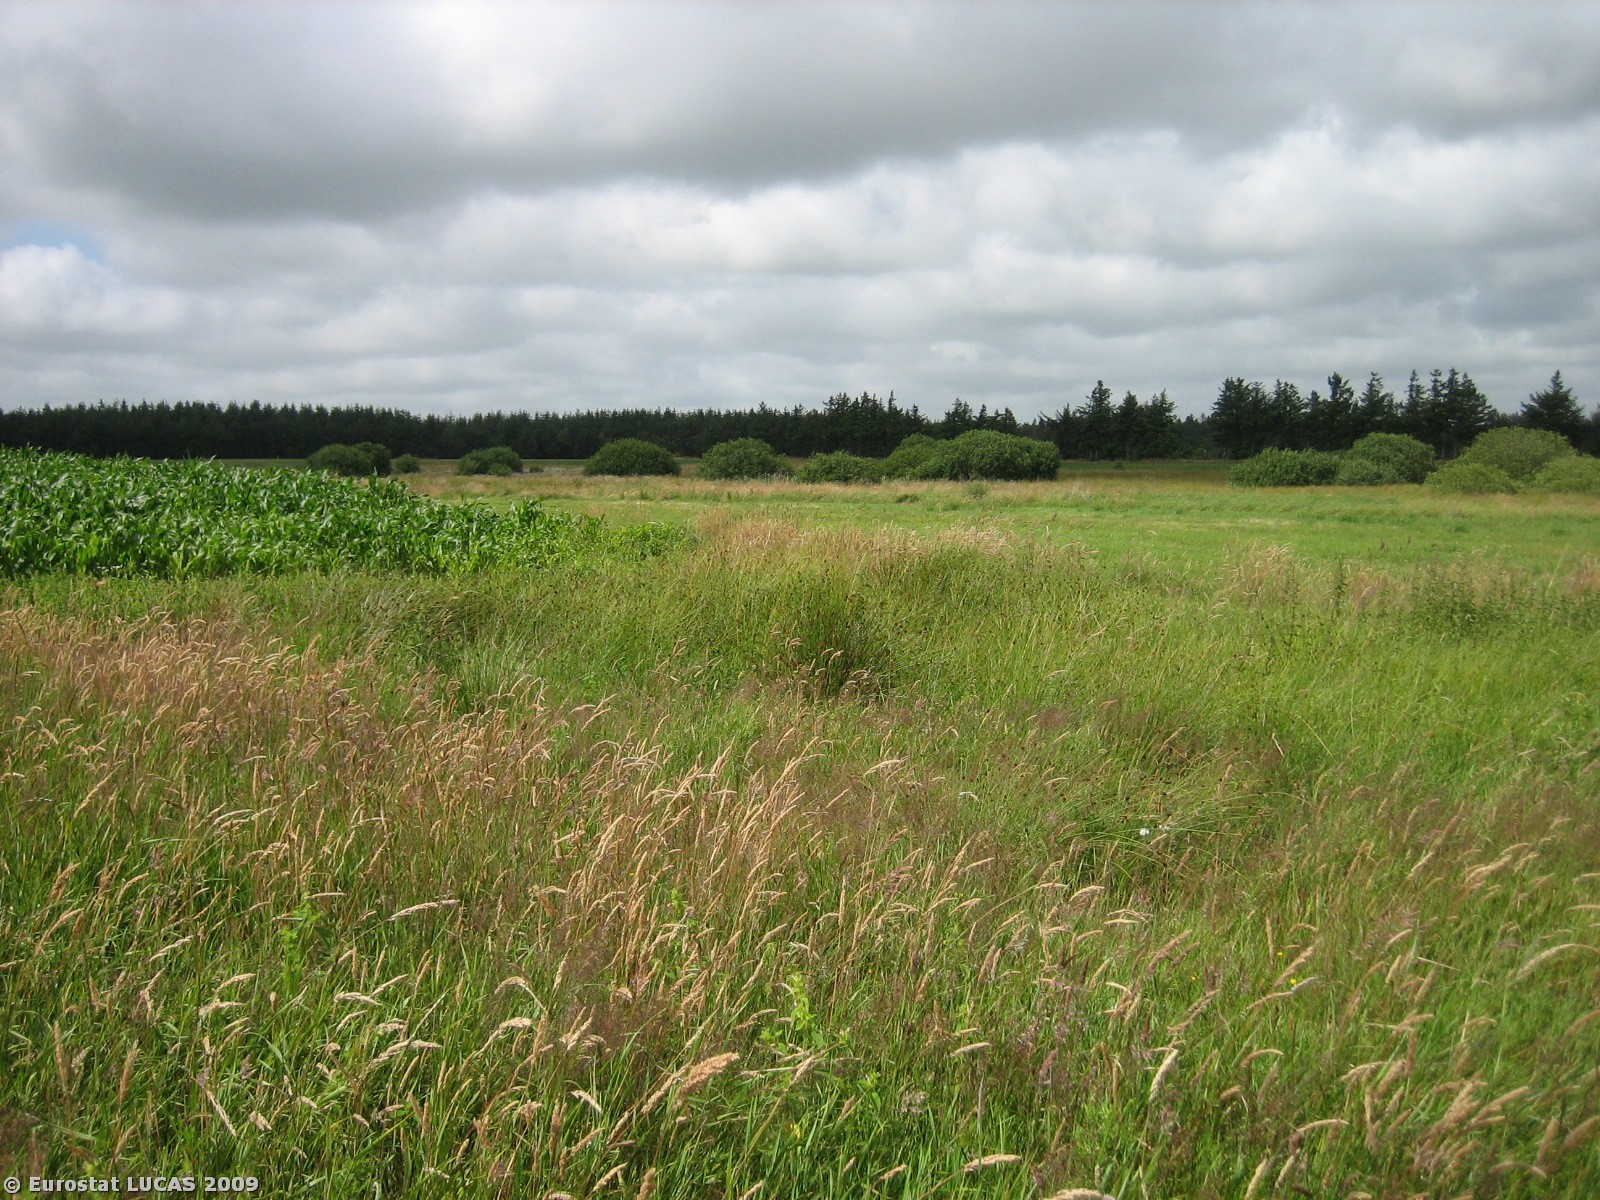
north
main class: Grassland
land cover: Grassland without tree/shrub cover
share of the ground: > 75 %
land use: Unused
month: July
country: DK
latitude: 55.6747
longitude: 8.4272
